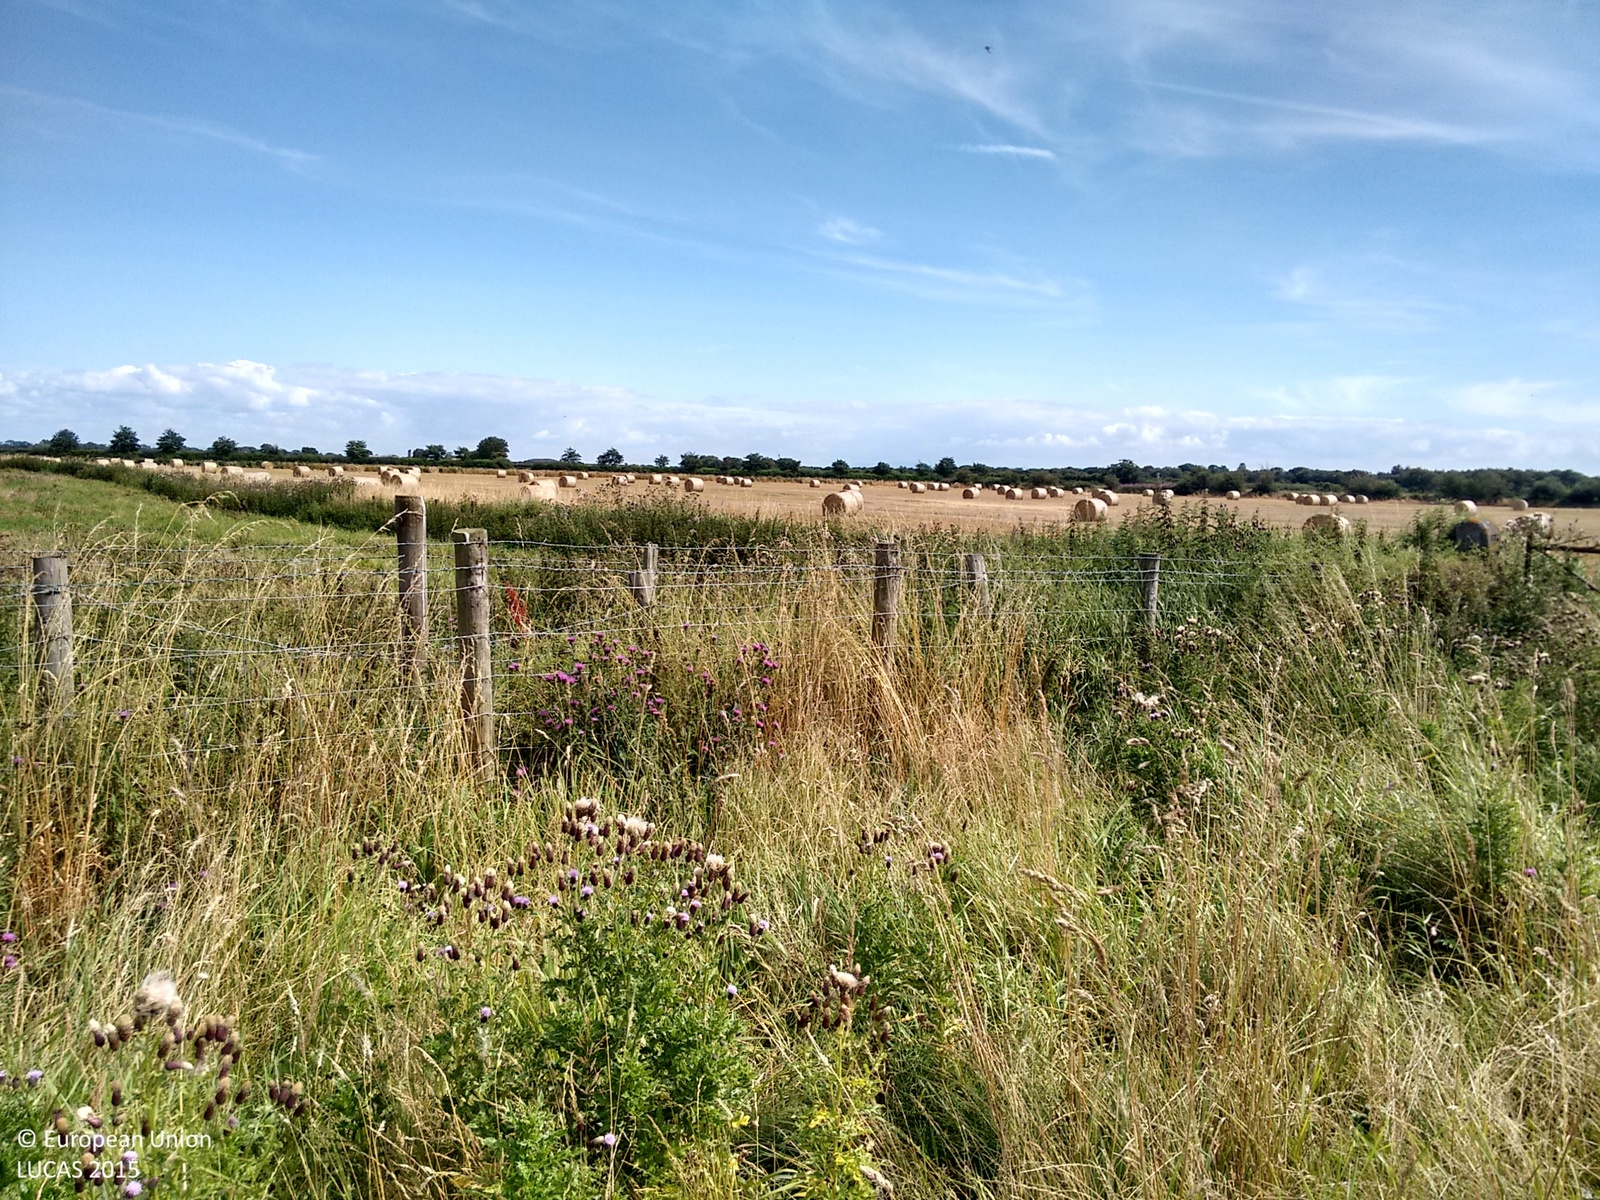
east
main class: Cropland
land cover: Barley
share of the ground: > 75 %
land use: Agriculture (excluding fallow land and kitchen gardens)
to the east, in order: Barley; Managed hedges; Fences; Temporary grasslands; Fences; Grass margins; Fences; Managed hedges; Temporary grasslands
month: August
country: GB
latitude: 54.8767
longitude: -3.2456
